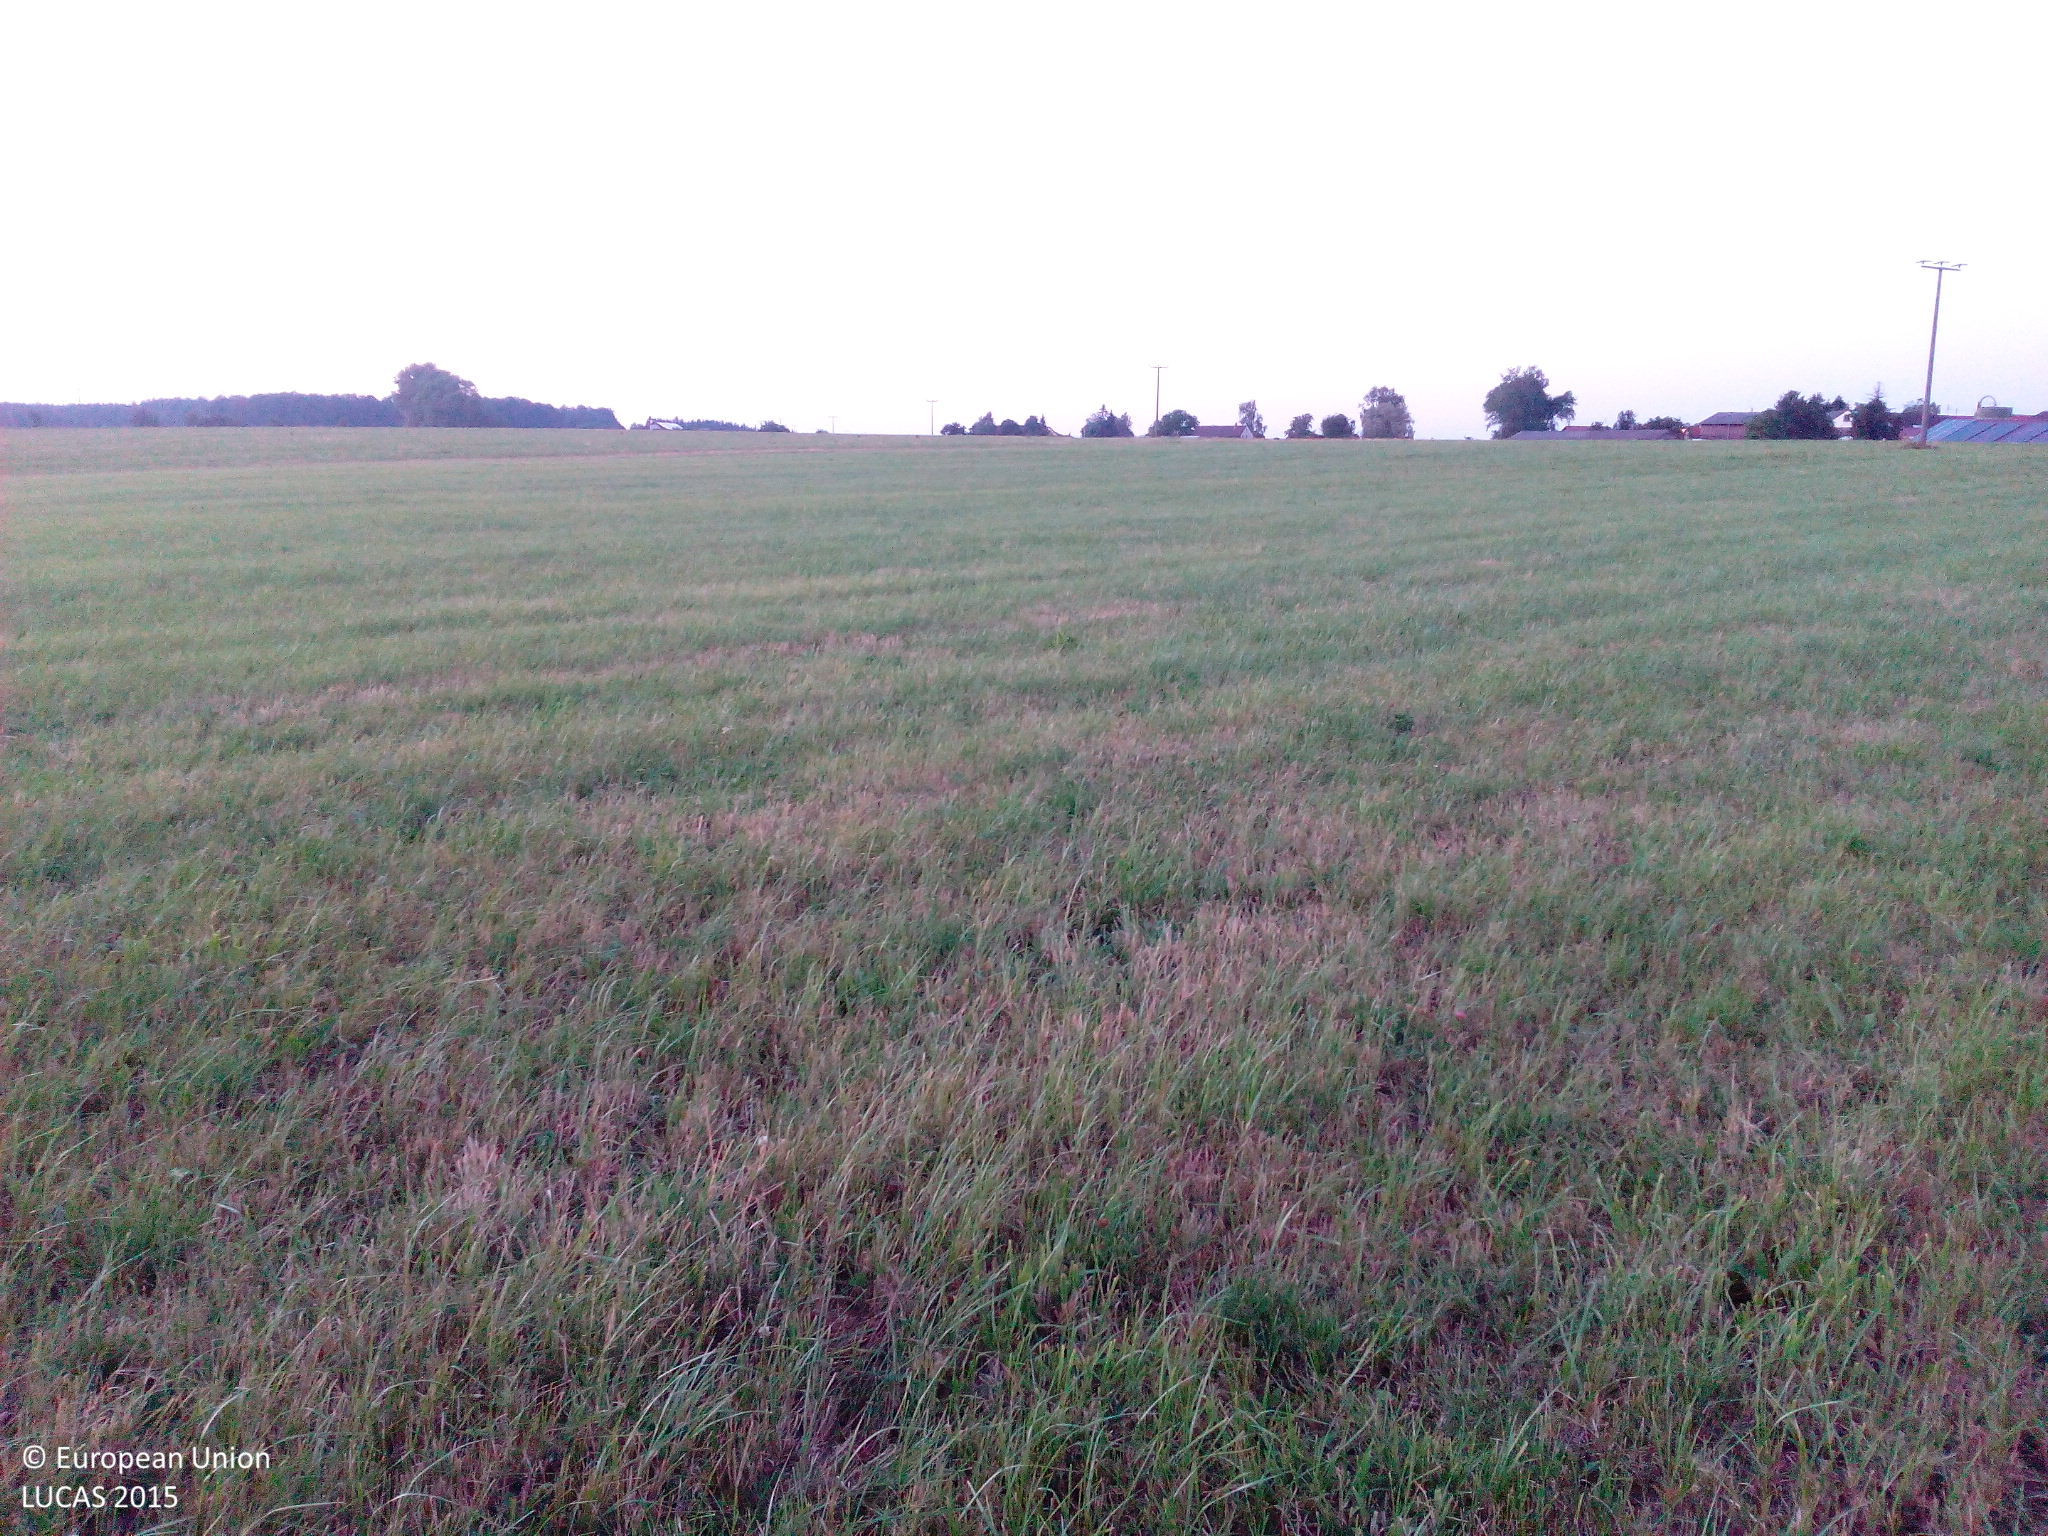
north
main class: Grassland
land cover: Grassland without tree/shrub cover
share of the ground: > 75 %
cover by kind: herbaceous plants 95 %, unconsolidated bare surface 5 %
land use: Agriculture (excluding fallow land and kitchen gardens)
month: July
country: DE
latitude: 48.9428
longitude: 10.3139
